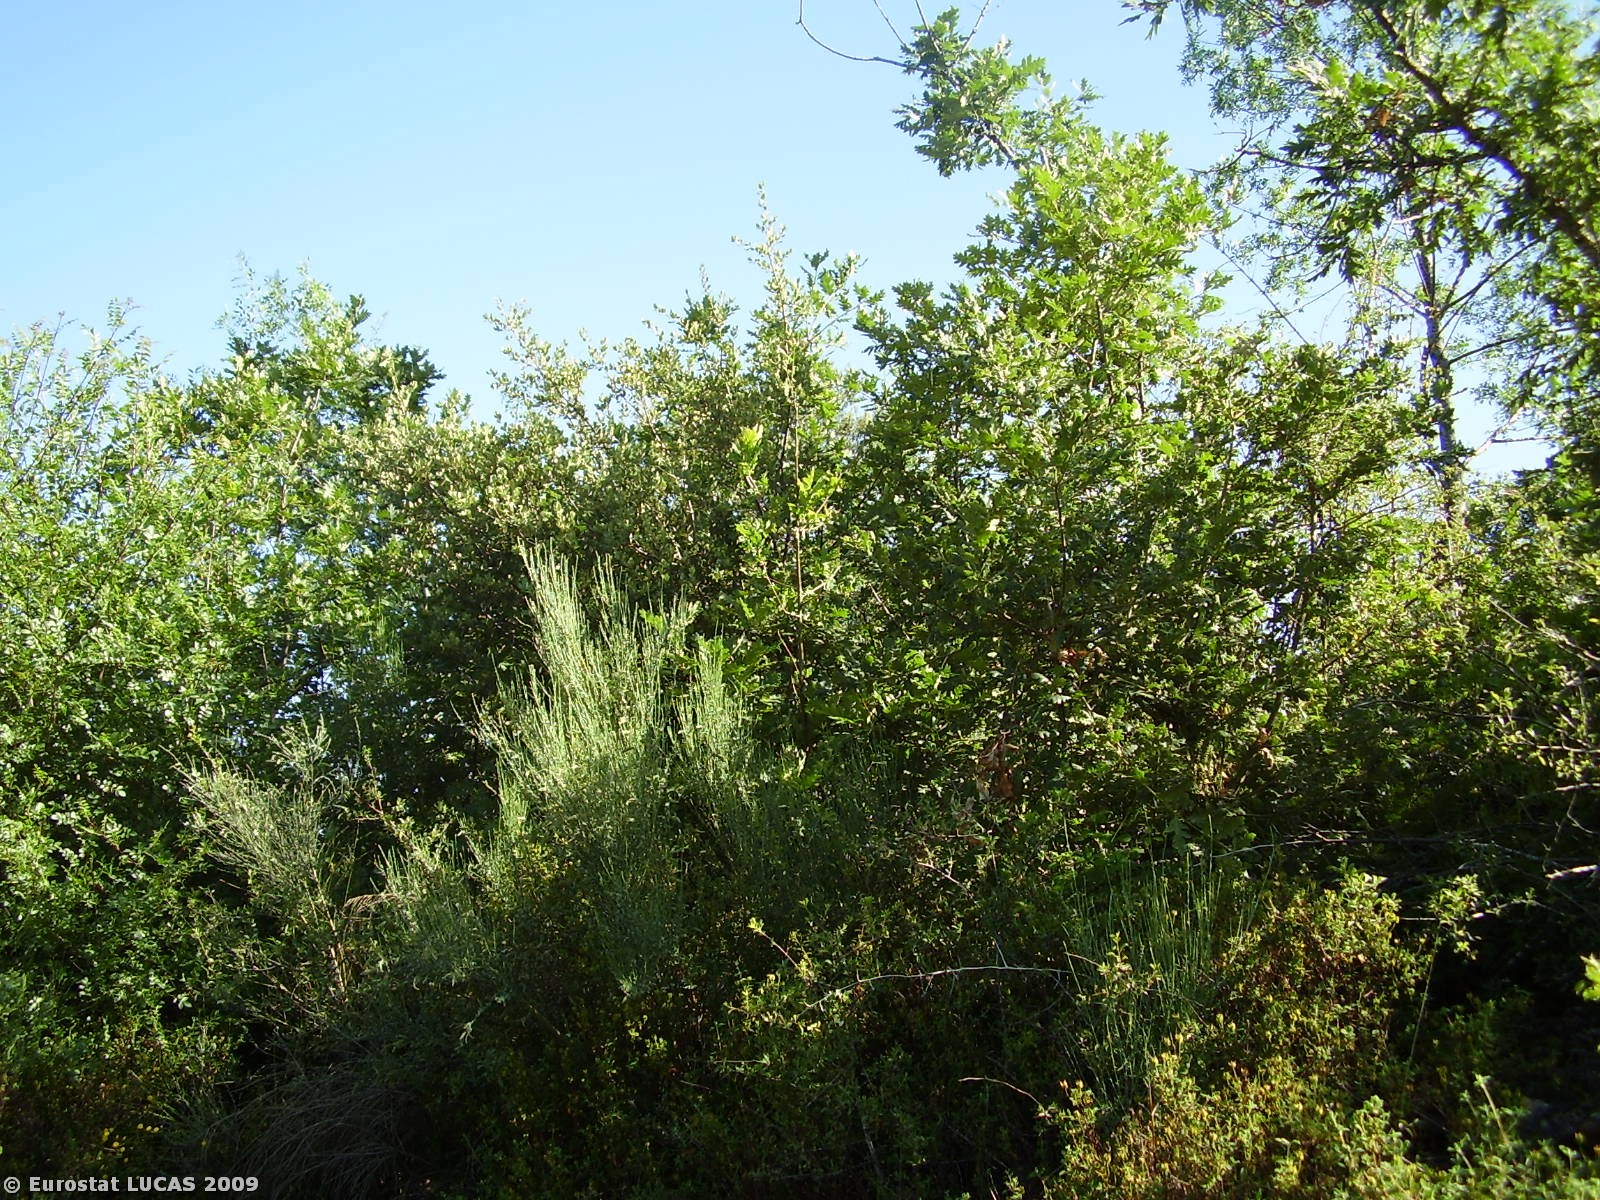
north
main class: Cropland
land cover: Vineyards
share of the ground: 25 - 50 %
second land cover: Bare land
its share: 10 - 25 %
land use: Agriculture (excluding fallow land and kitchen gardens)
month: June
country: PT
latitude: 41.8015
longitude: -6.9555
